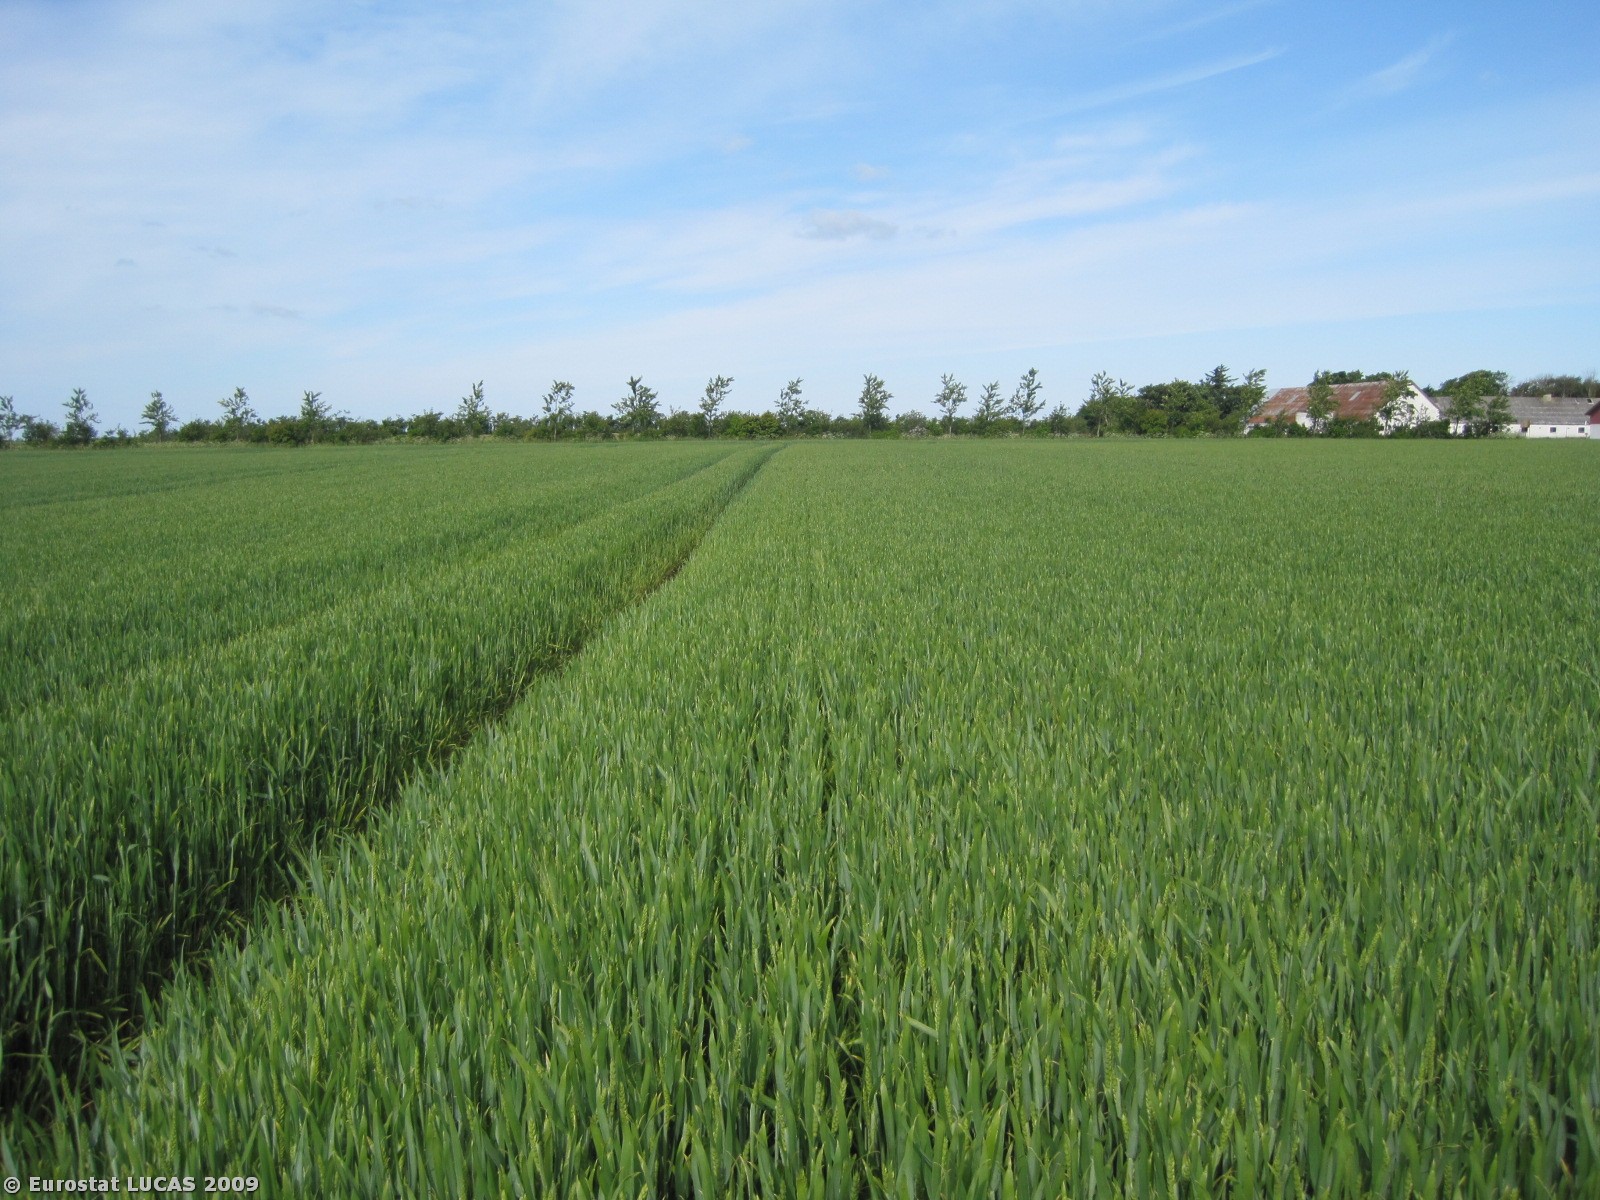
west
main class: Cropland
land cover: Common wheat
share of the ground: > 75 %
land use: Agriculture (excluding fallow land and kitchen gardens)
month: June
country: DK
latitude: 57.4101
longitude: 9.8504
